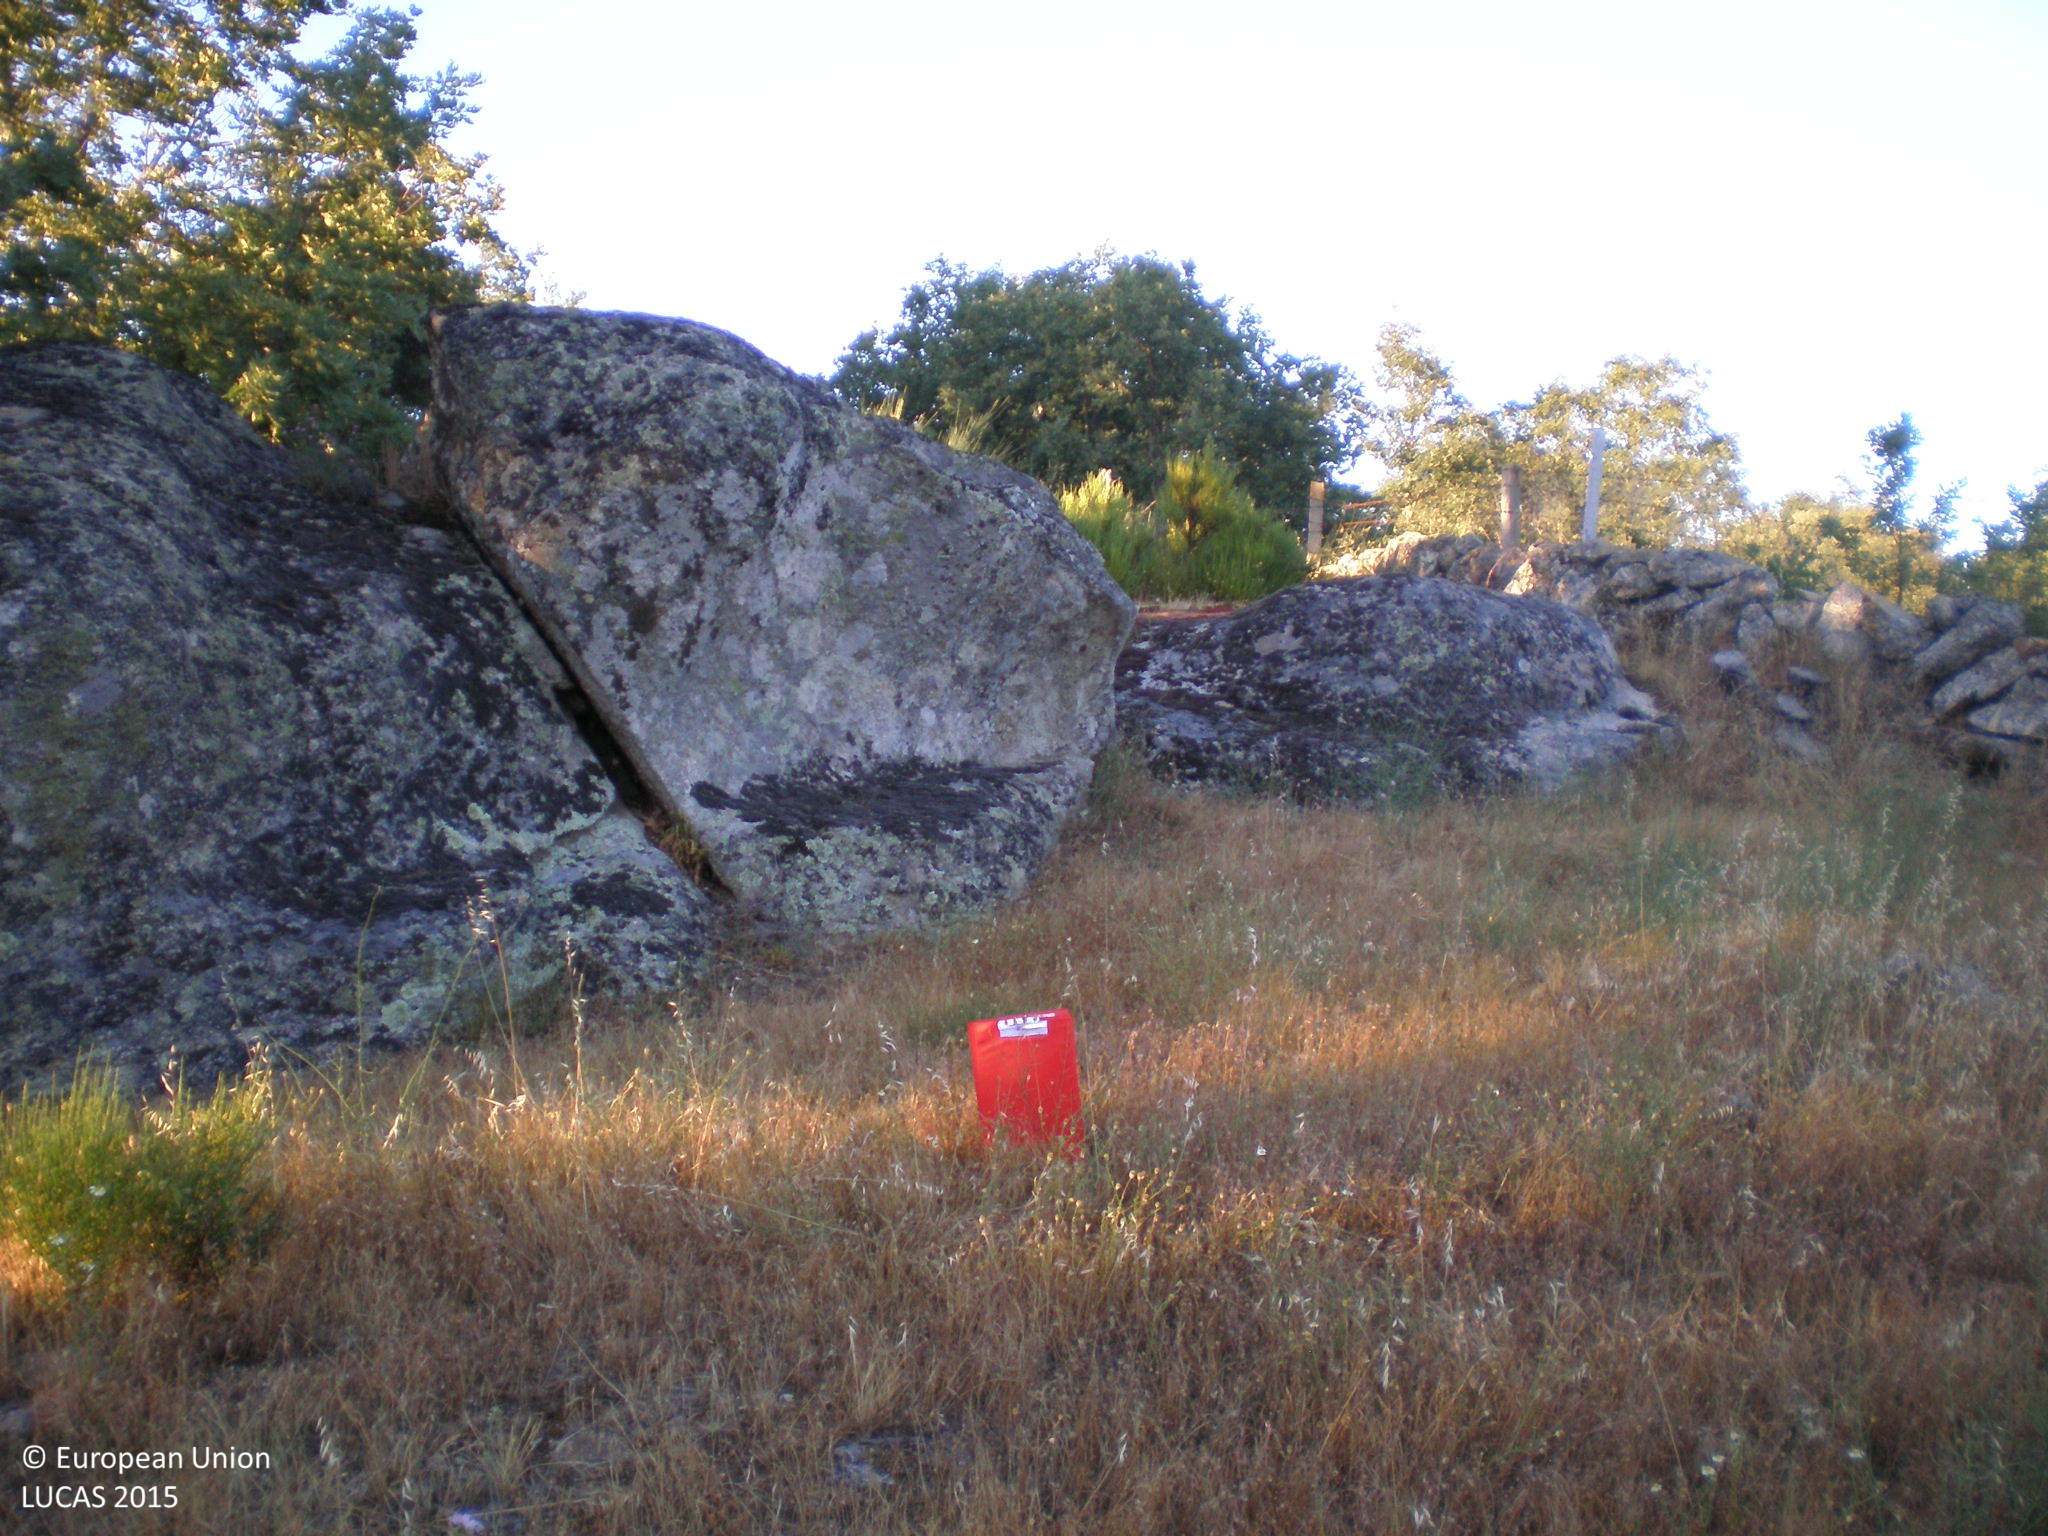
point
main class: Grassland
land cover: Grassland with sparse tree/shrub cover
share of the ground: > 75 %
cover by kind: herbaceous plants 95 %, broadleaved forest trees 5 %
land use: Agriculture (excluding fallow land and kitchen gardens)
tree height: < 5 m
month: June
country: ES
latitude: 40.5391
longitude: -5.8121
